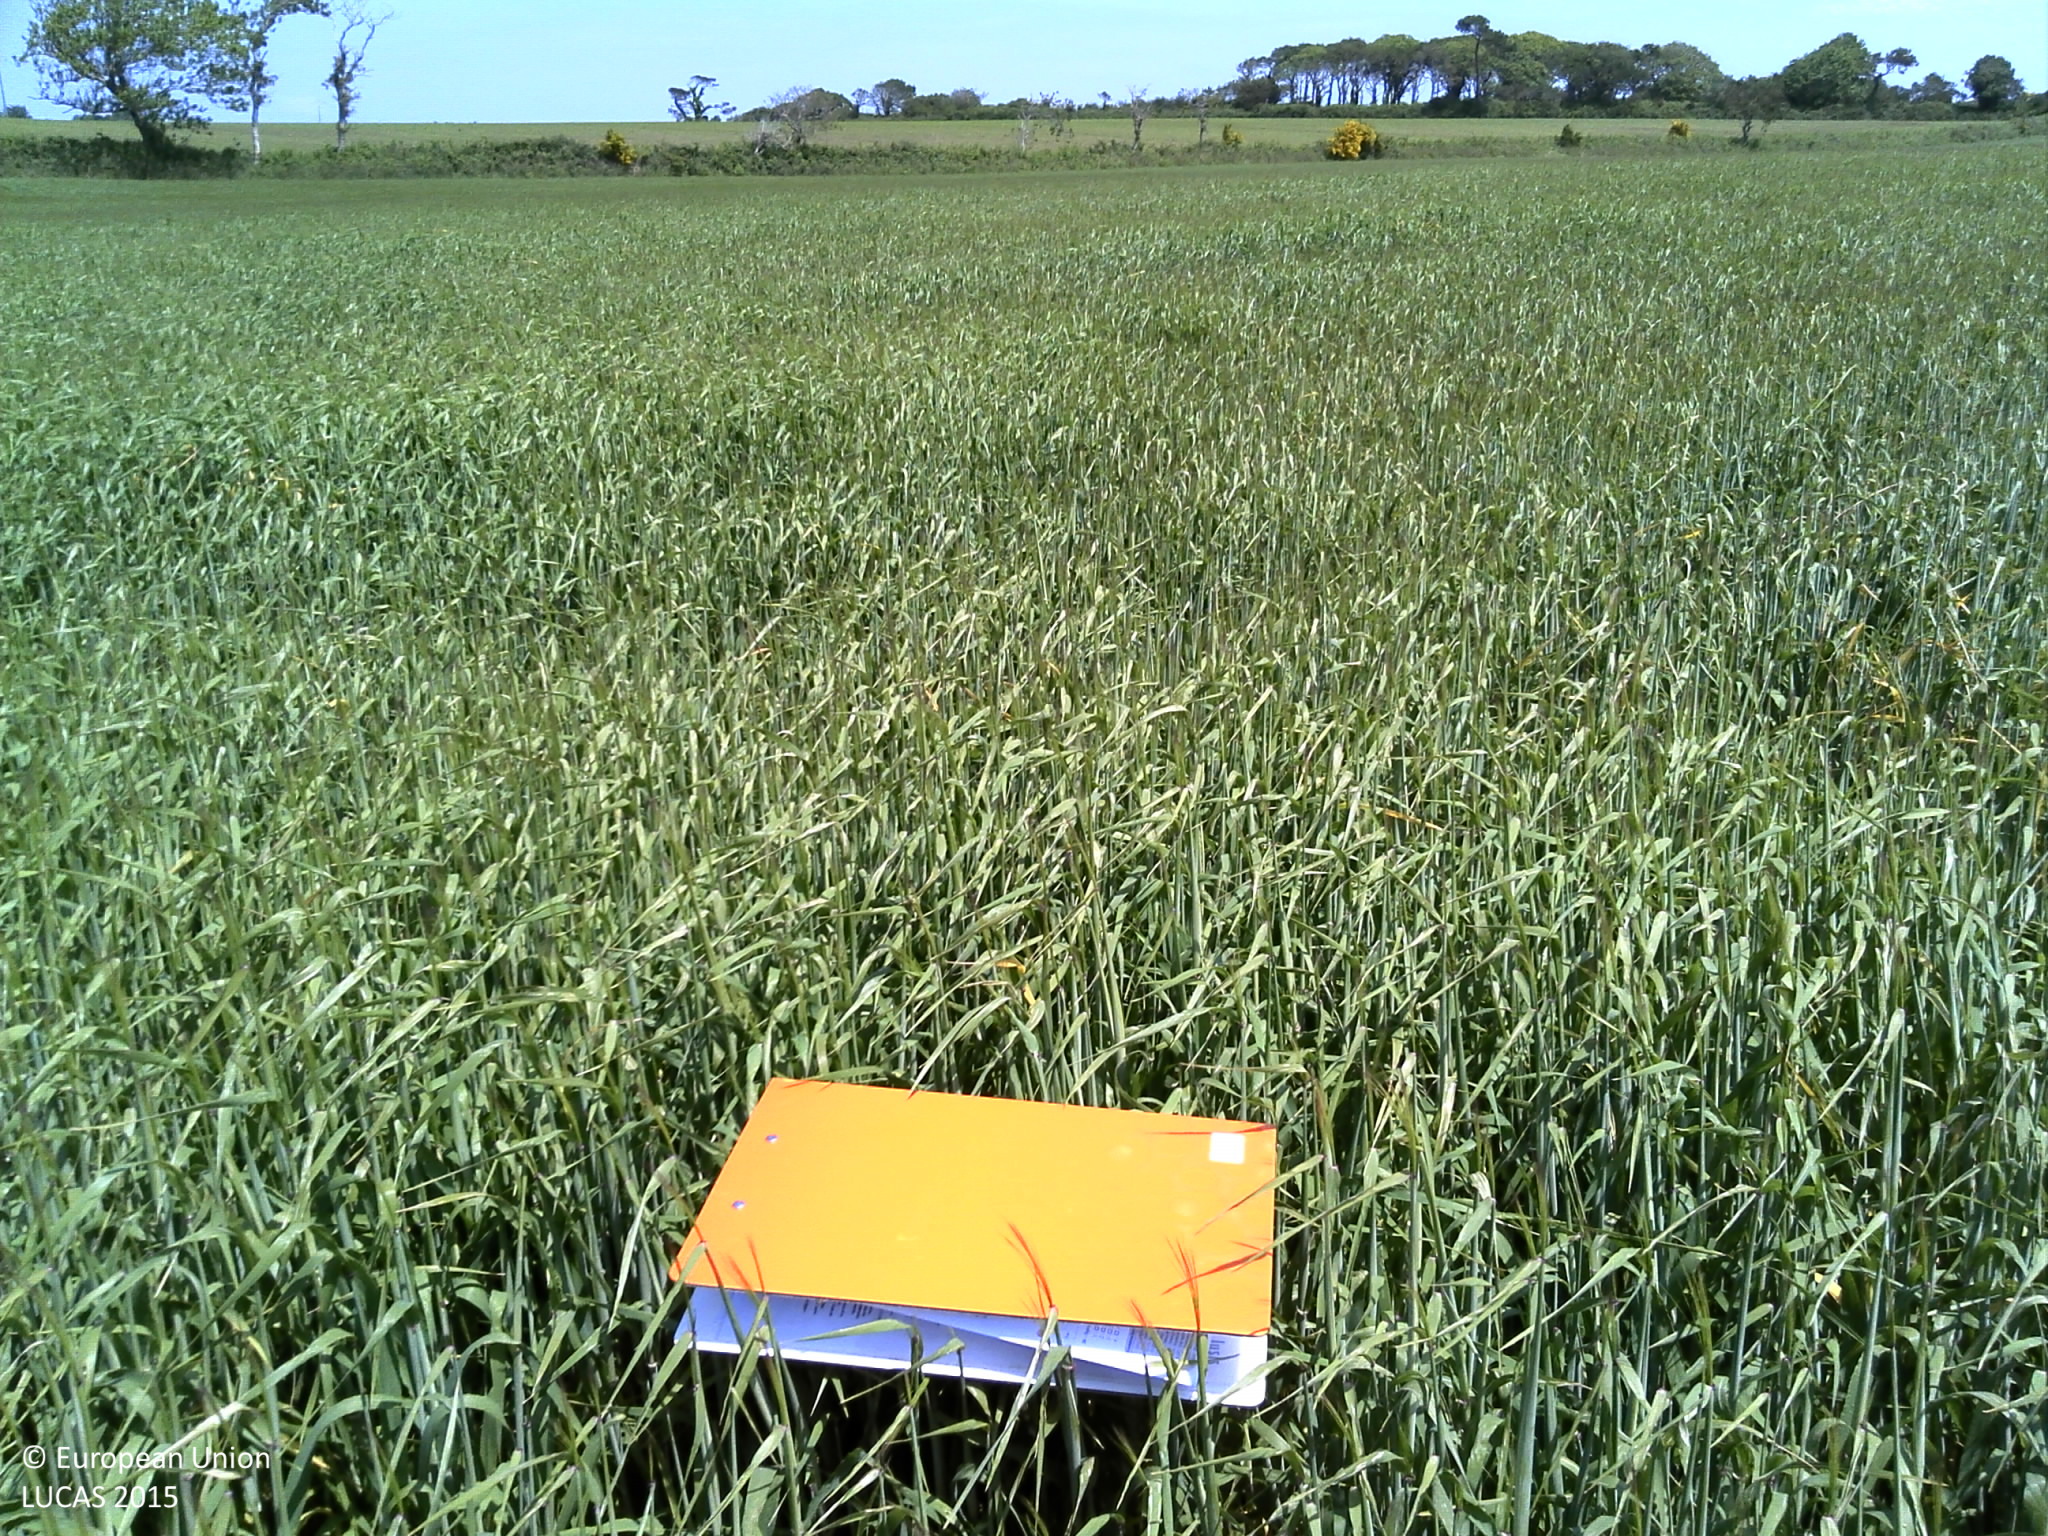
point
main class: Cropland
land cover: Barley
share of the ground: > 75 %
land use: Agriculture (excluding fallow land and kitchen gardens)
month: June
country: FR
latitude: 47.9858
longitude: -4.3908
